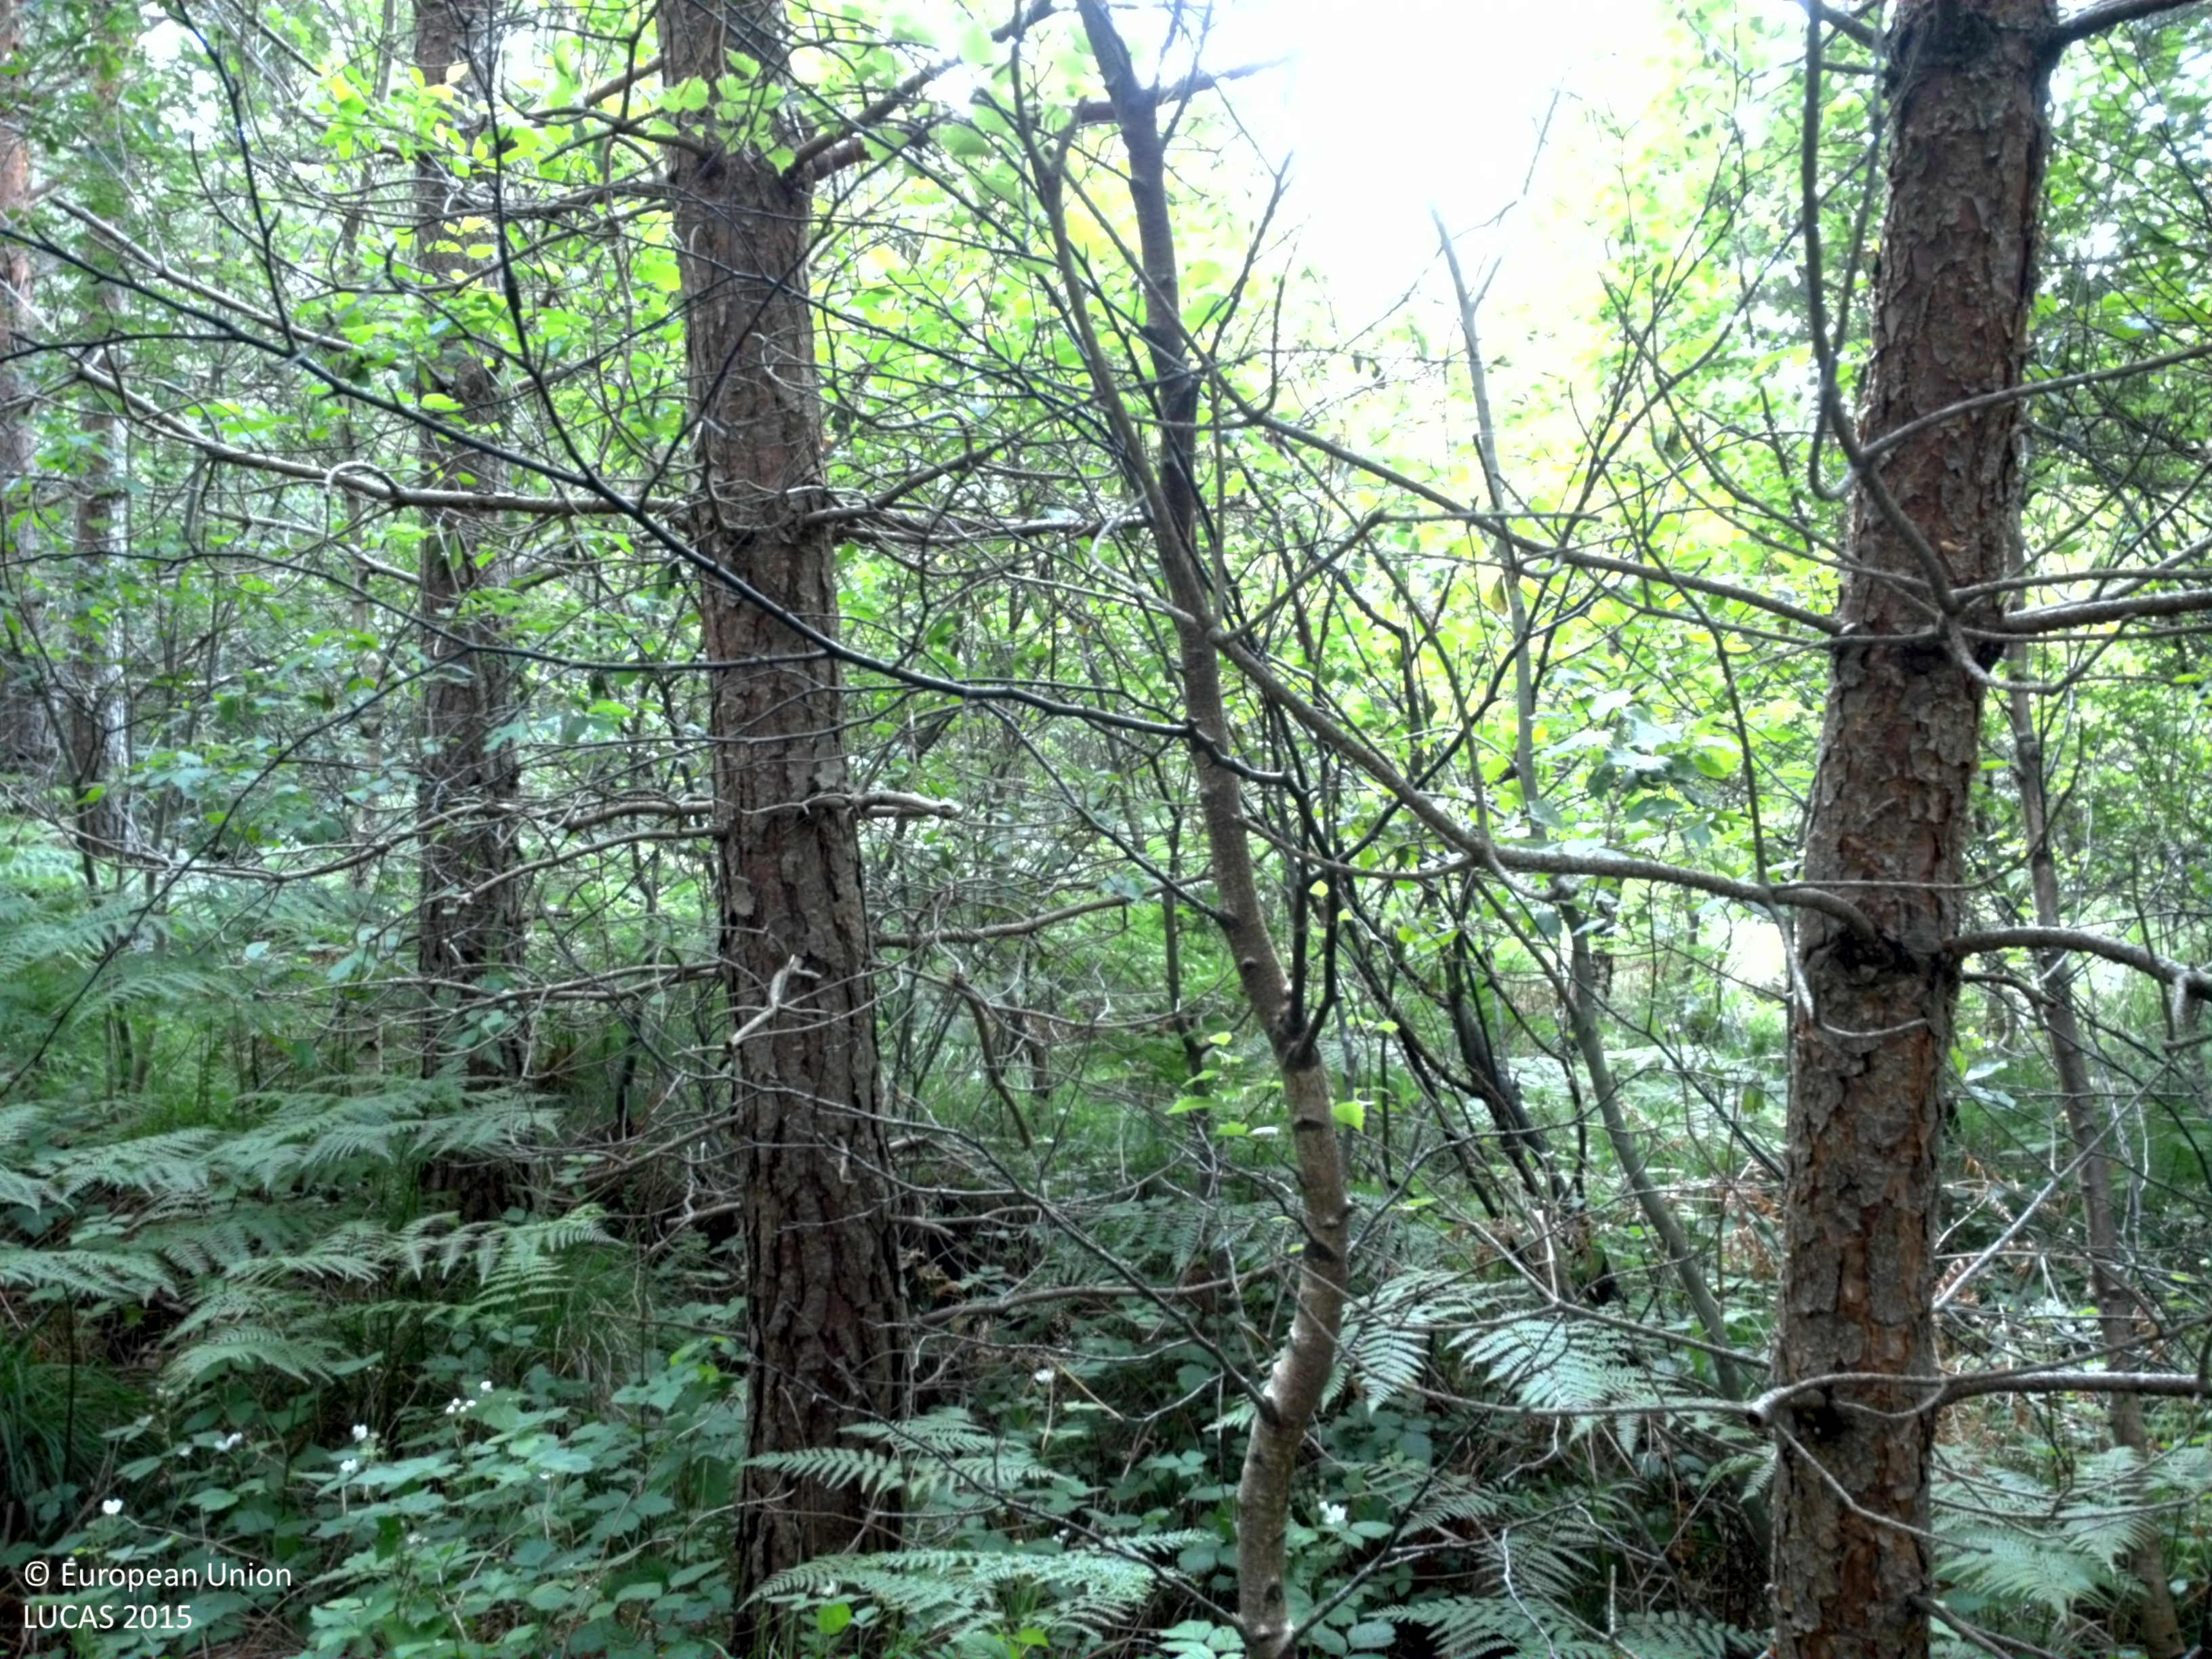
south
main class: Woodland
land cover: Pine dominated mixed woodland
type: hemiboreal forest and nemoral coniferous forest and mixed broadleaved-coniferous forest
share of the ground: > 75 %
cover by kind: coniferous forest trees 55 %, broadleaved forest trees 25 %, herbaceous plants 15 %, shrubs 5 %
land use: Forestry
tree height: > 5 m
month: July
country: SE
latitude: 57.2864
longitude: 18.1197
